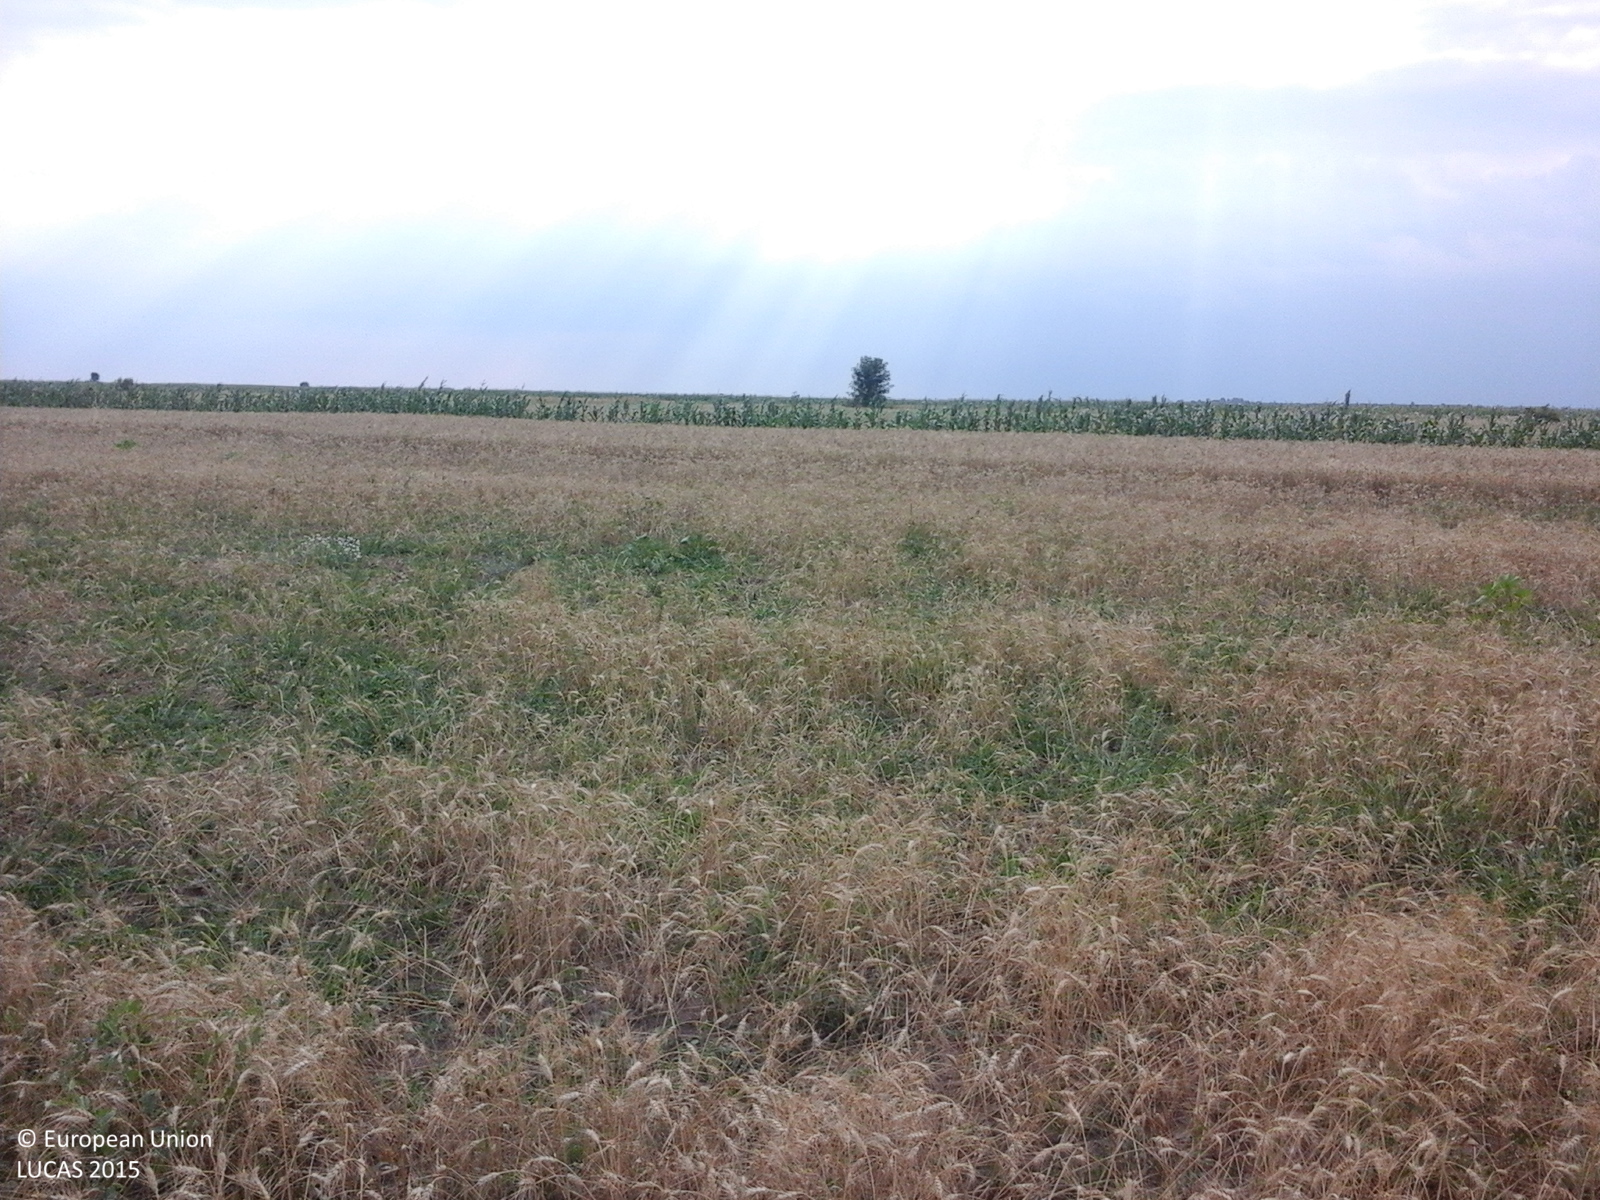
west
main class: Cropland
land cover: Common wheat
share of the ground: > 75 %
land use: Agriculture (excluding fallow land and kitchen gardens)
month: July
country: RO
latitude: 44.1358
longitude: 24.0718
